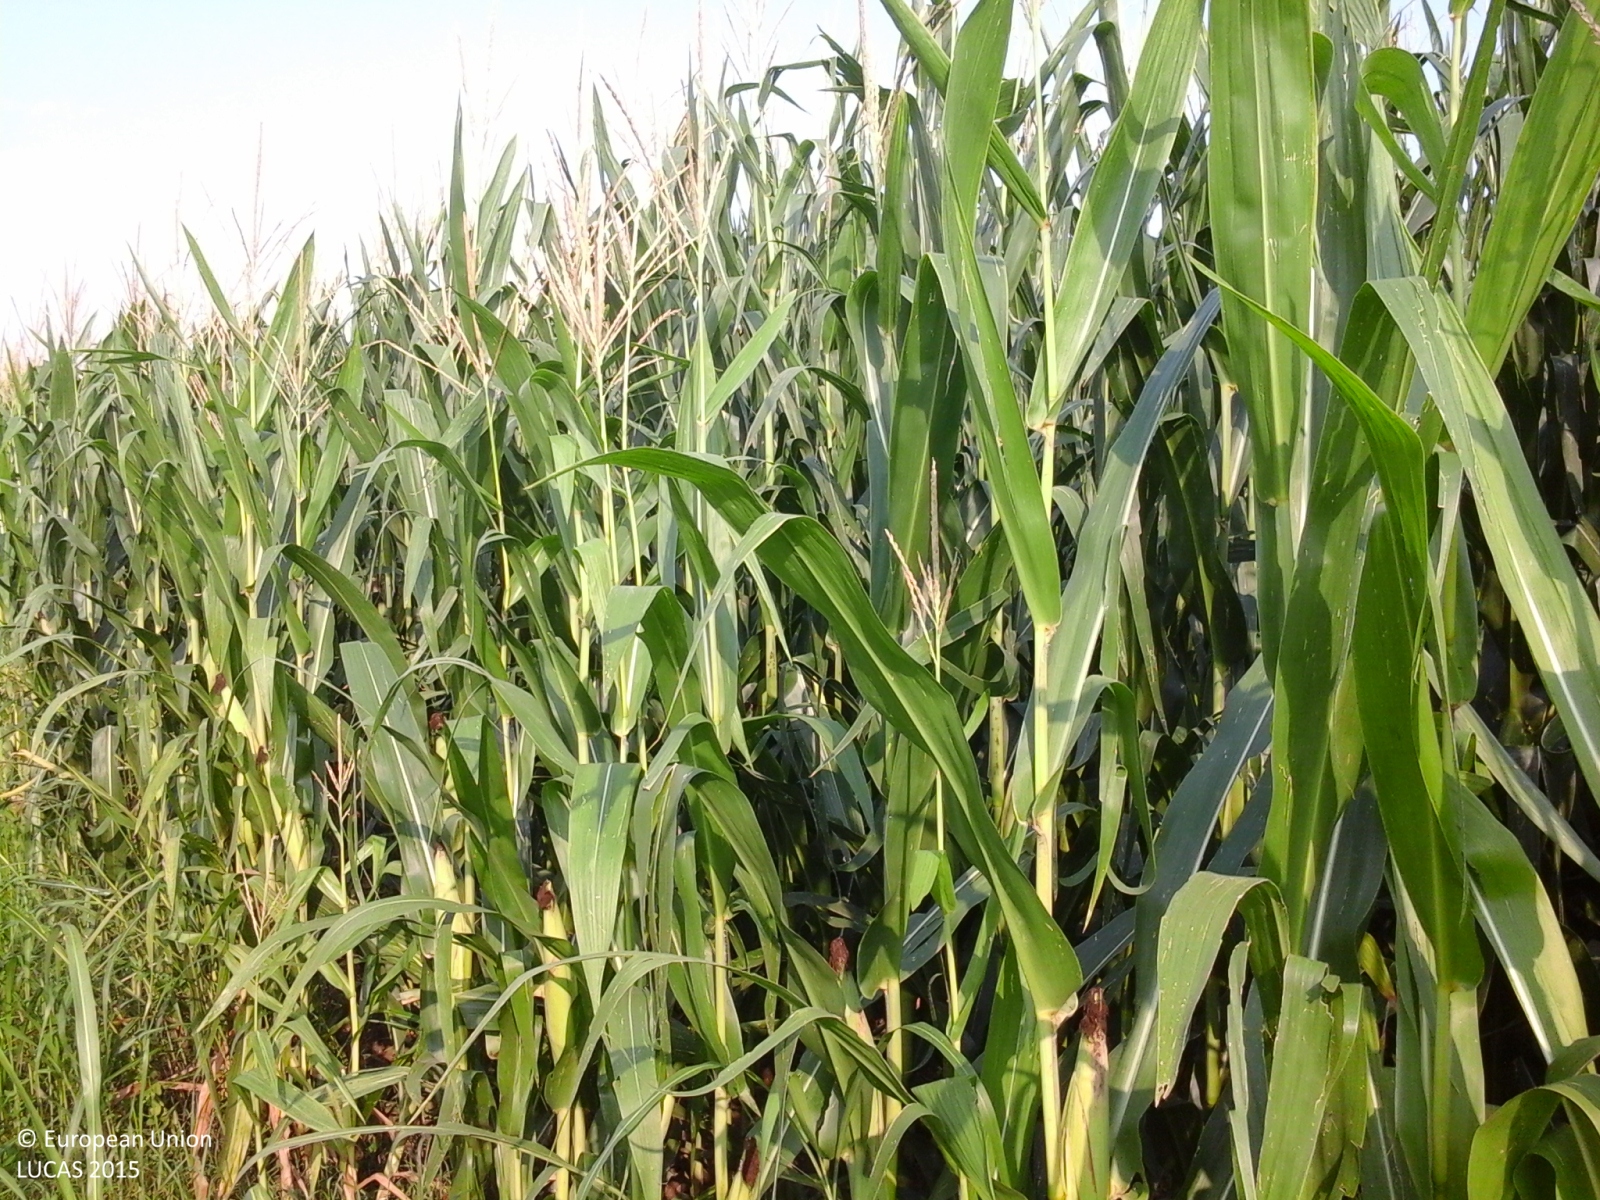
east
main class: Cropland
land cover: Maize
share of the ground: > 75 %
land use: Agriculture (excluding fallow land and kitchen gardens)
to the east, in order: Maize; Broadleaved woodland; Grassland without tree/shrub cover; Fences; Vineyards; Tracks; Vineyards; Electric lines; Vineyards; Lucerne; Maize; Vineyards
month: June
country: IT
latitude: 45.9276
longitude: 12.4083
